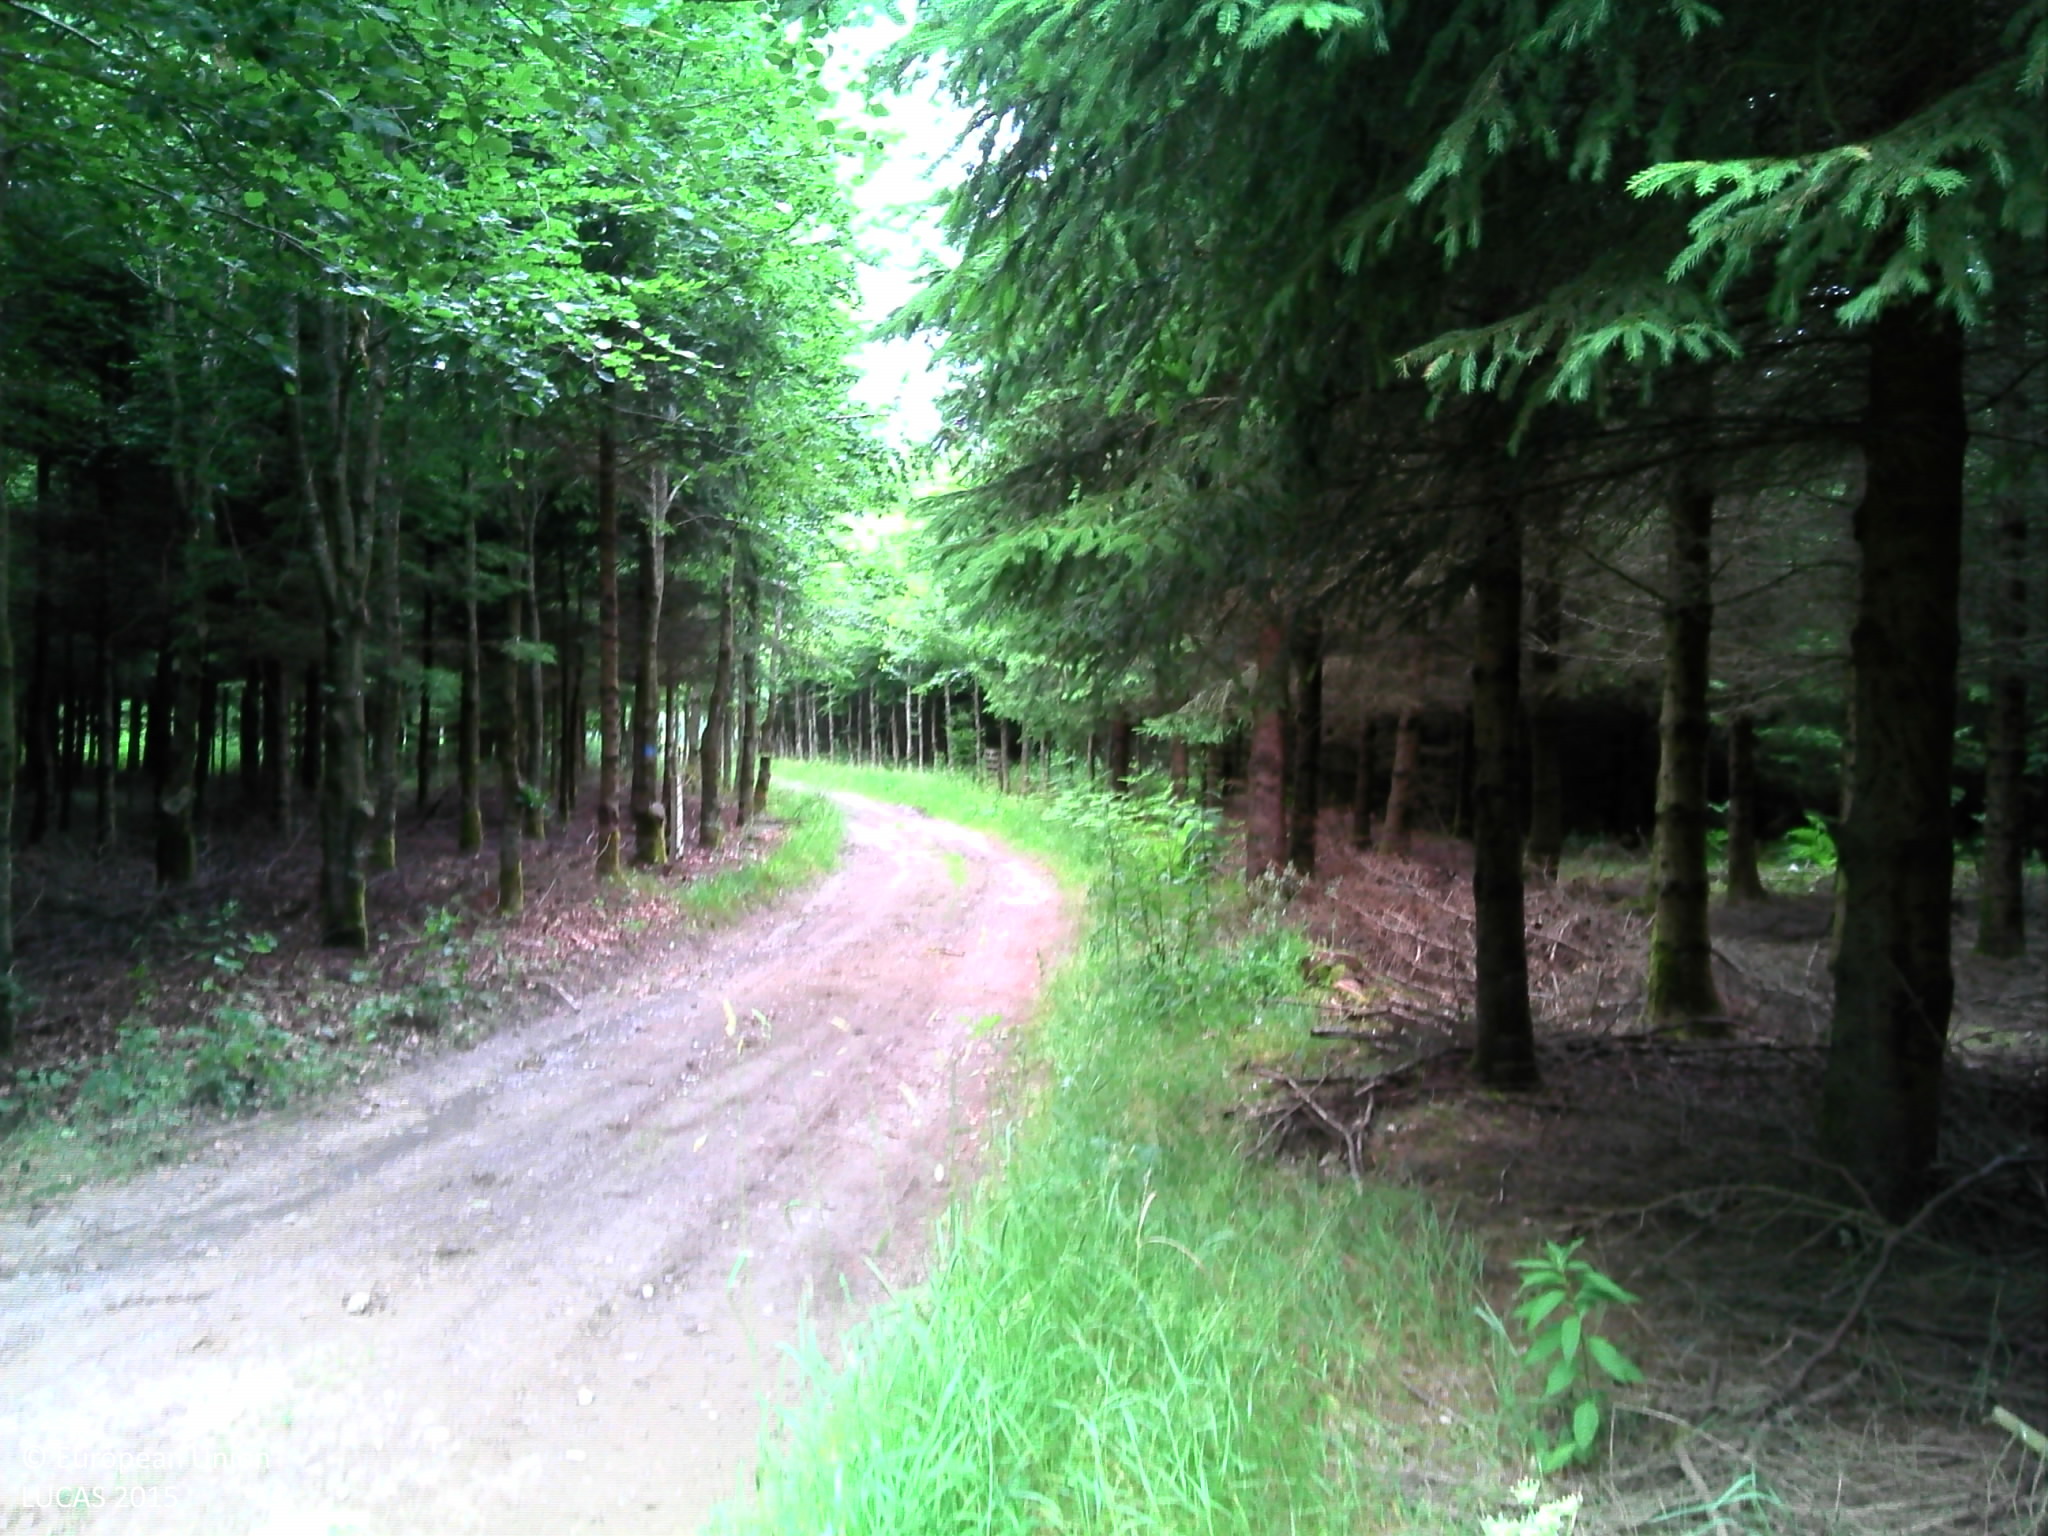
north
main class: Woodland
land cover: Spruce dominated coniferous woodland
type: hemiboreal forest and nemoral coniferous forest and mixed broadleaved-coniferous forest
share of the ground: > 75 %
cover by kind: coniferous forest trees 100 %
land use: Forestry
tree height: > 5 m
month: July
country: BE
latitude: 50.1794
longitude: 5.8118
